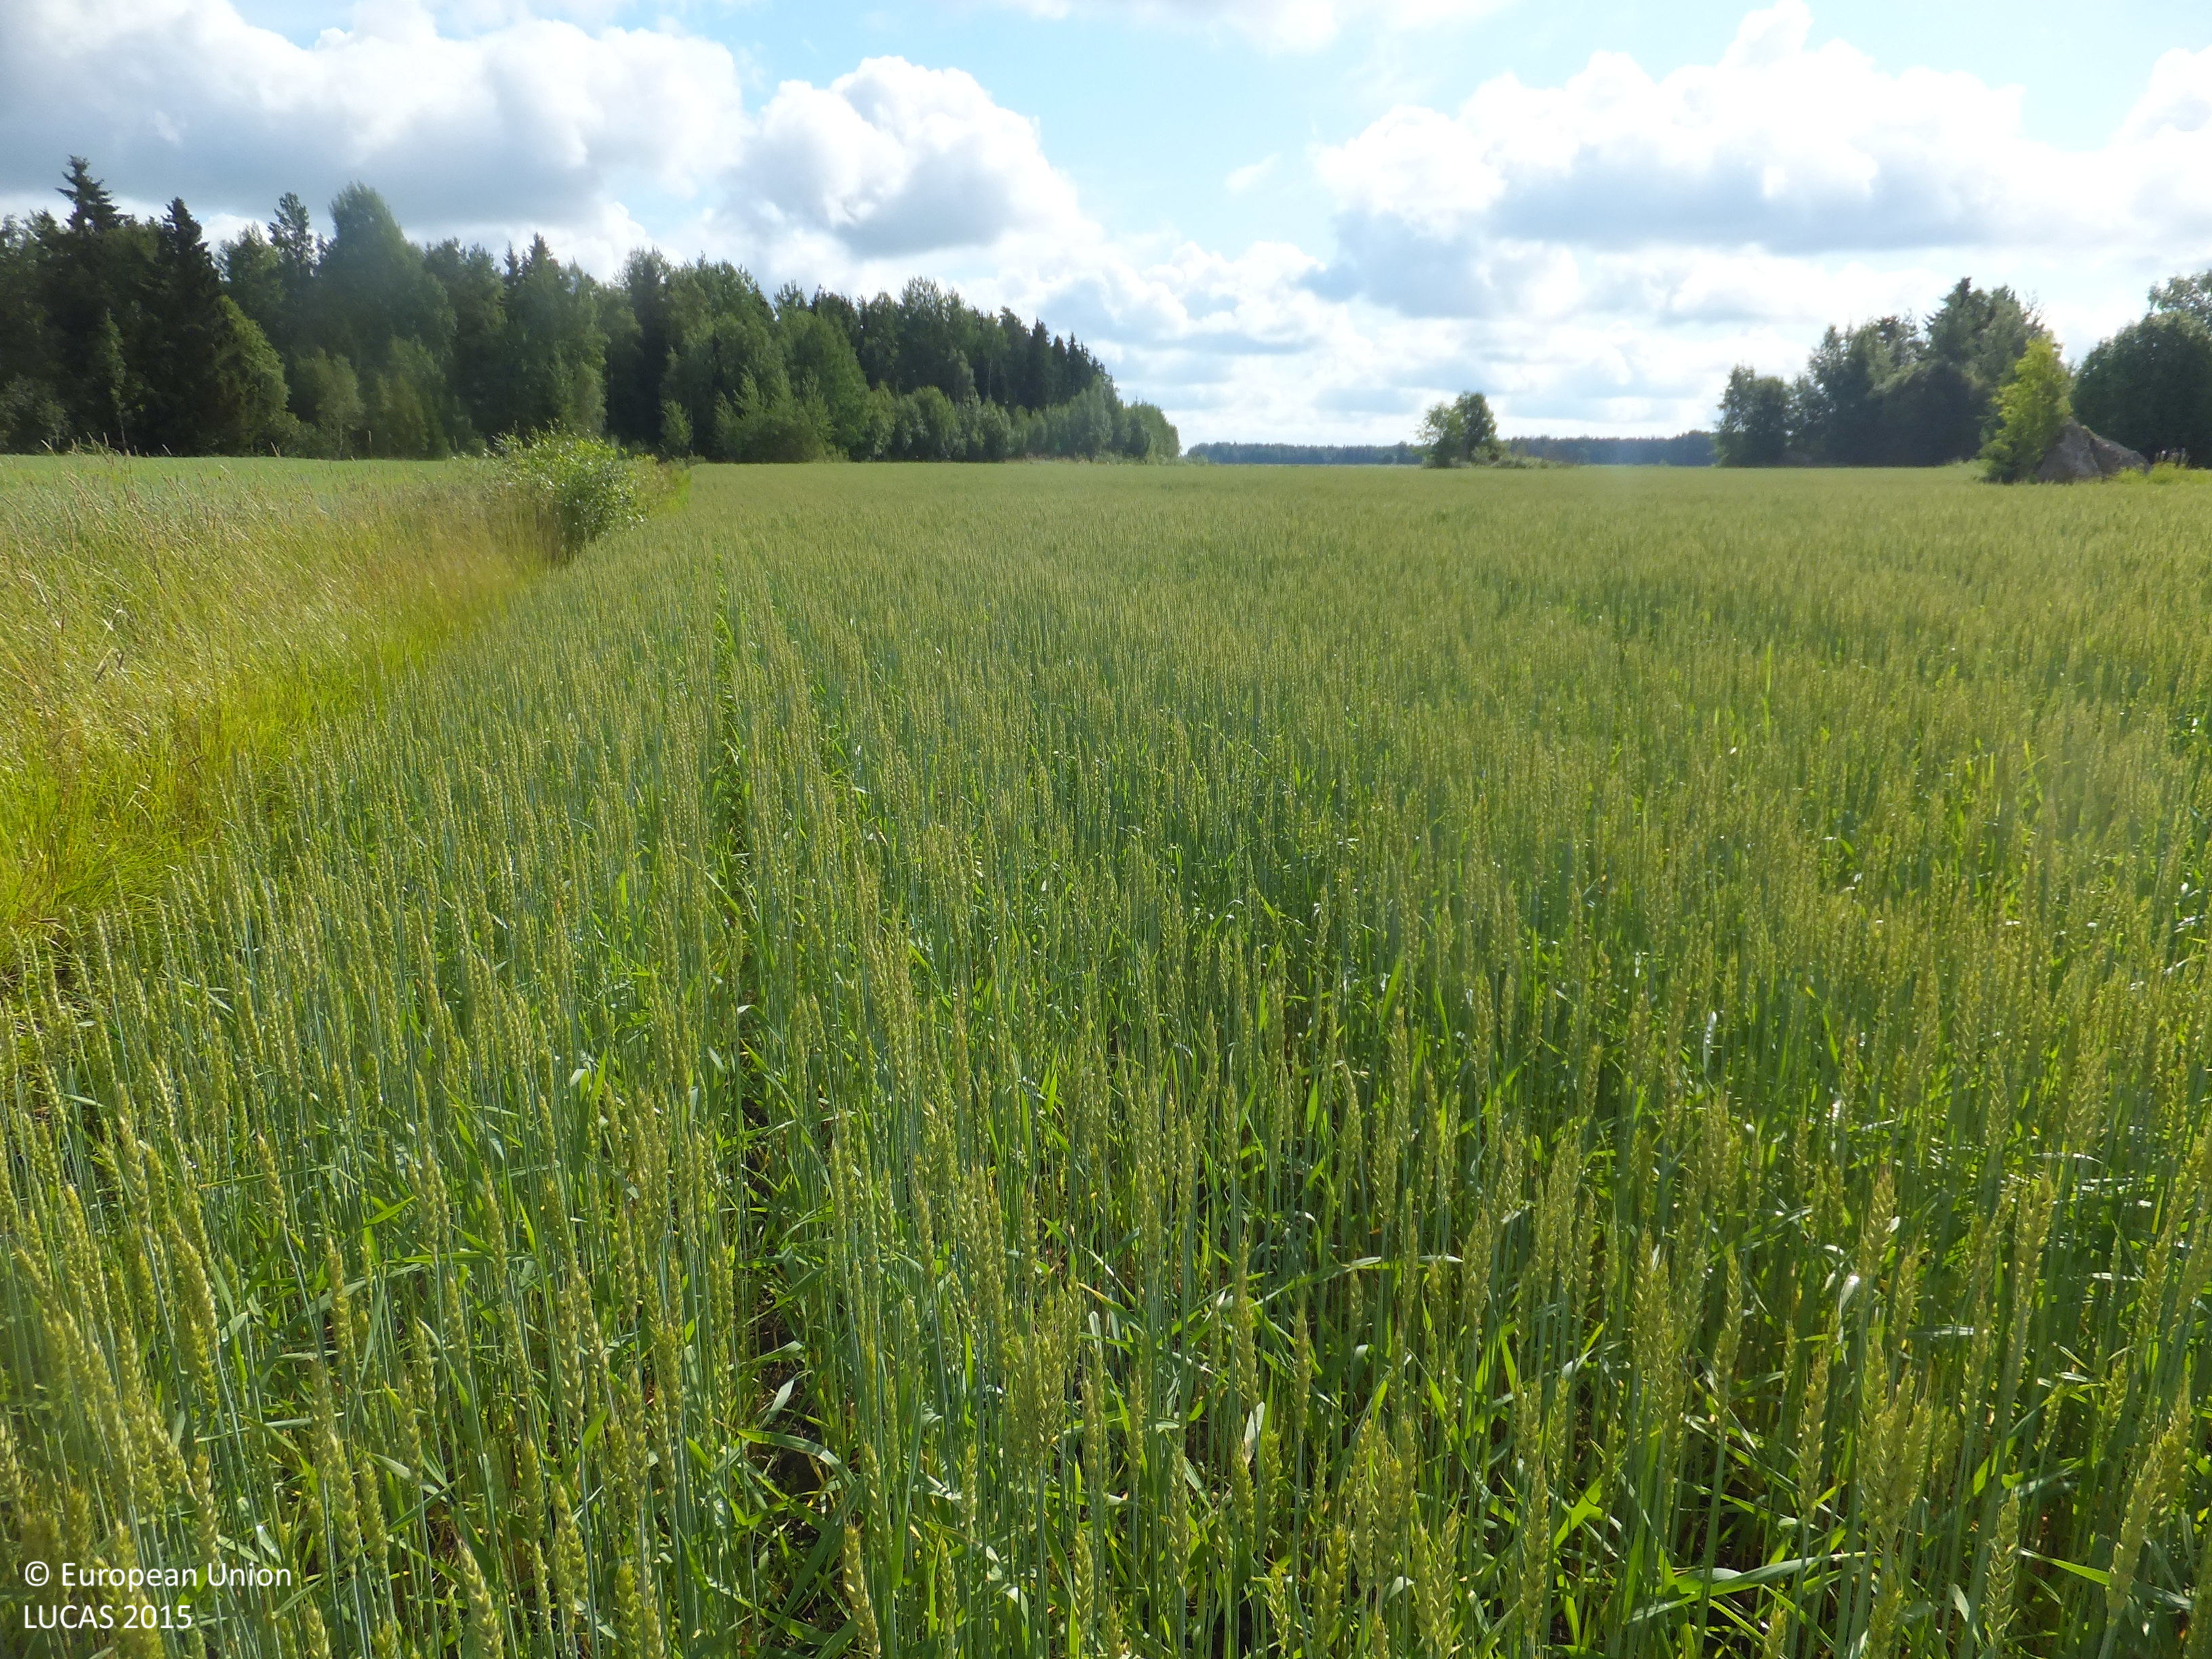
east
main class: Cropland
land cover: Common wheat
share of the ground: > 75 %
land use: Agriculture (excluding fallow land and kitchen gardens)
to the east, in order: Common wheat; Grass margins; Ditches and canals; Grass margins; Oats; Ditches and canals; Other mixed woodland; Ditches and canals; Other mixed woodland; Ditches and canals; Other mixed woodland
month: July
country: FI
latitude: 63.0702
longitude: 22.1387
